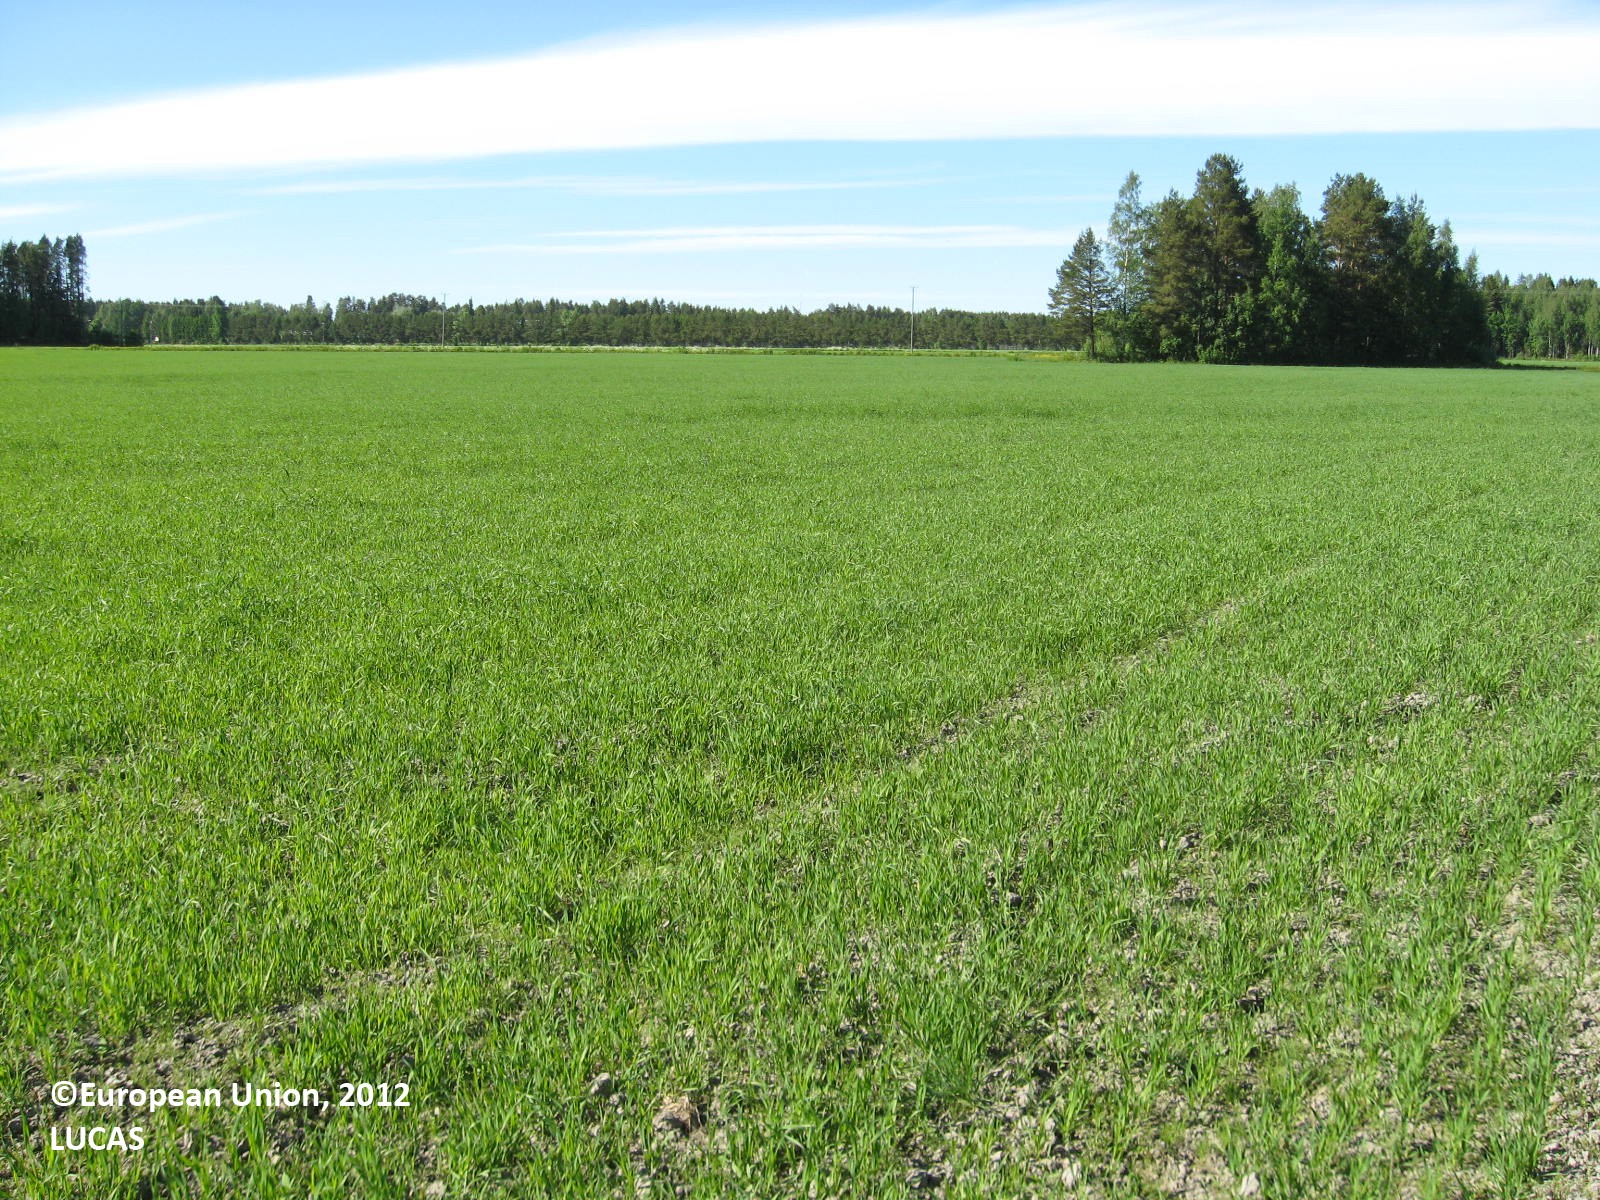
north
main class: Cropland
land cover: Rye
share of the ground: > 75 %
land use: Agriculture (excluding fallow land and kitchen gardens)
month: June
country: FI
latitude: 62.7431
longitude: 21.6493
